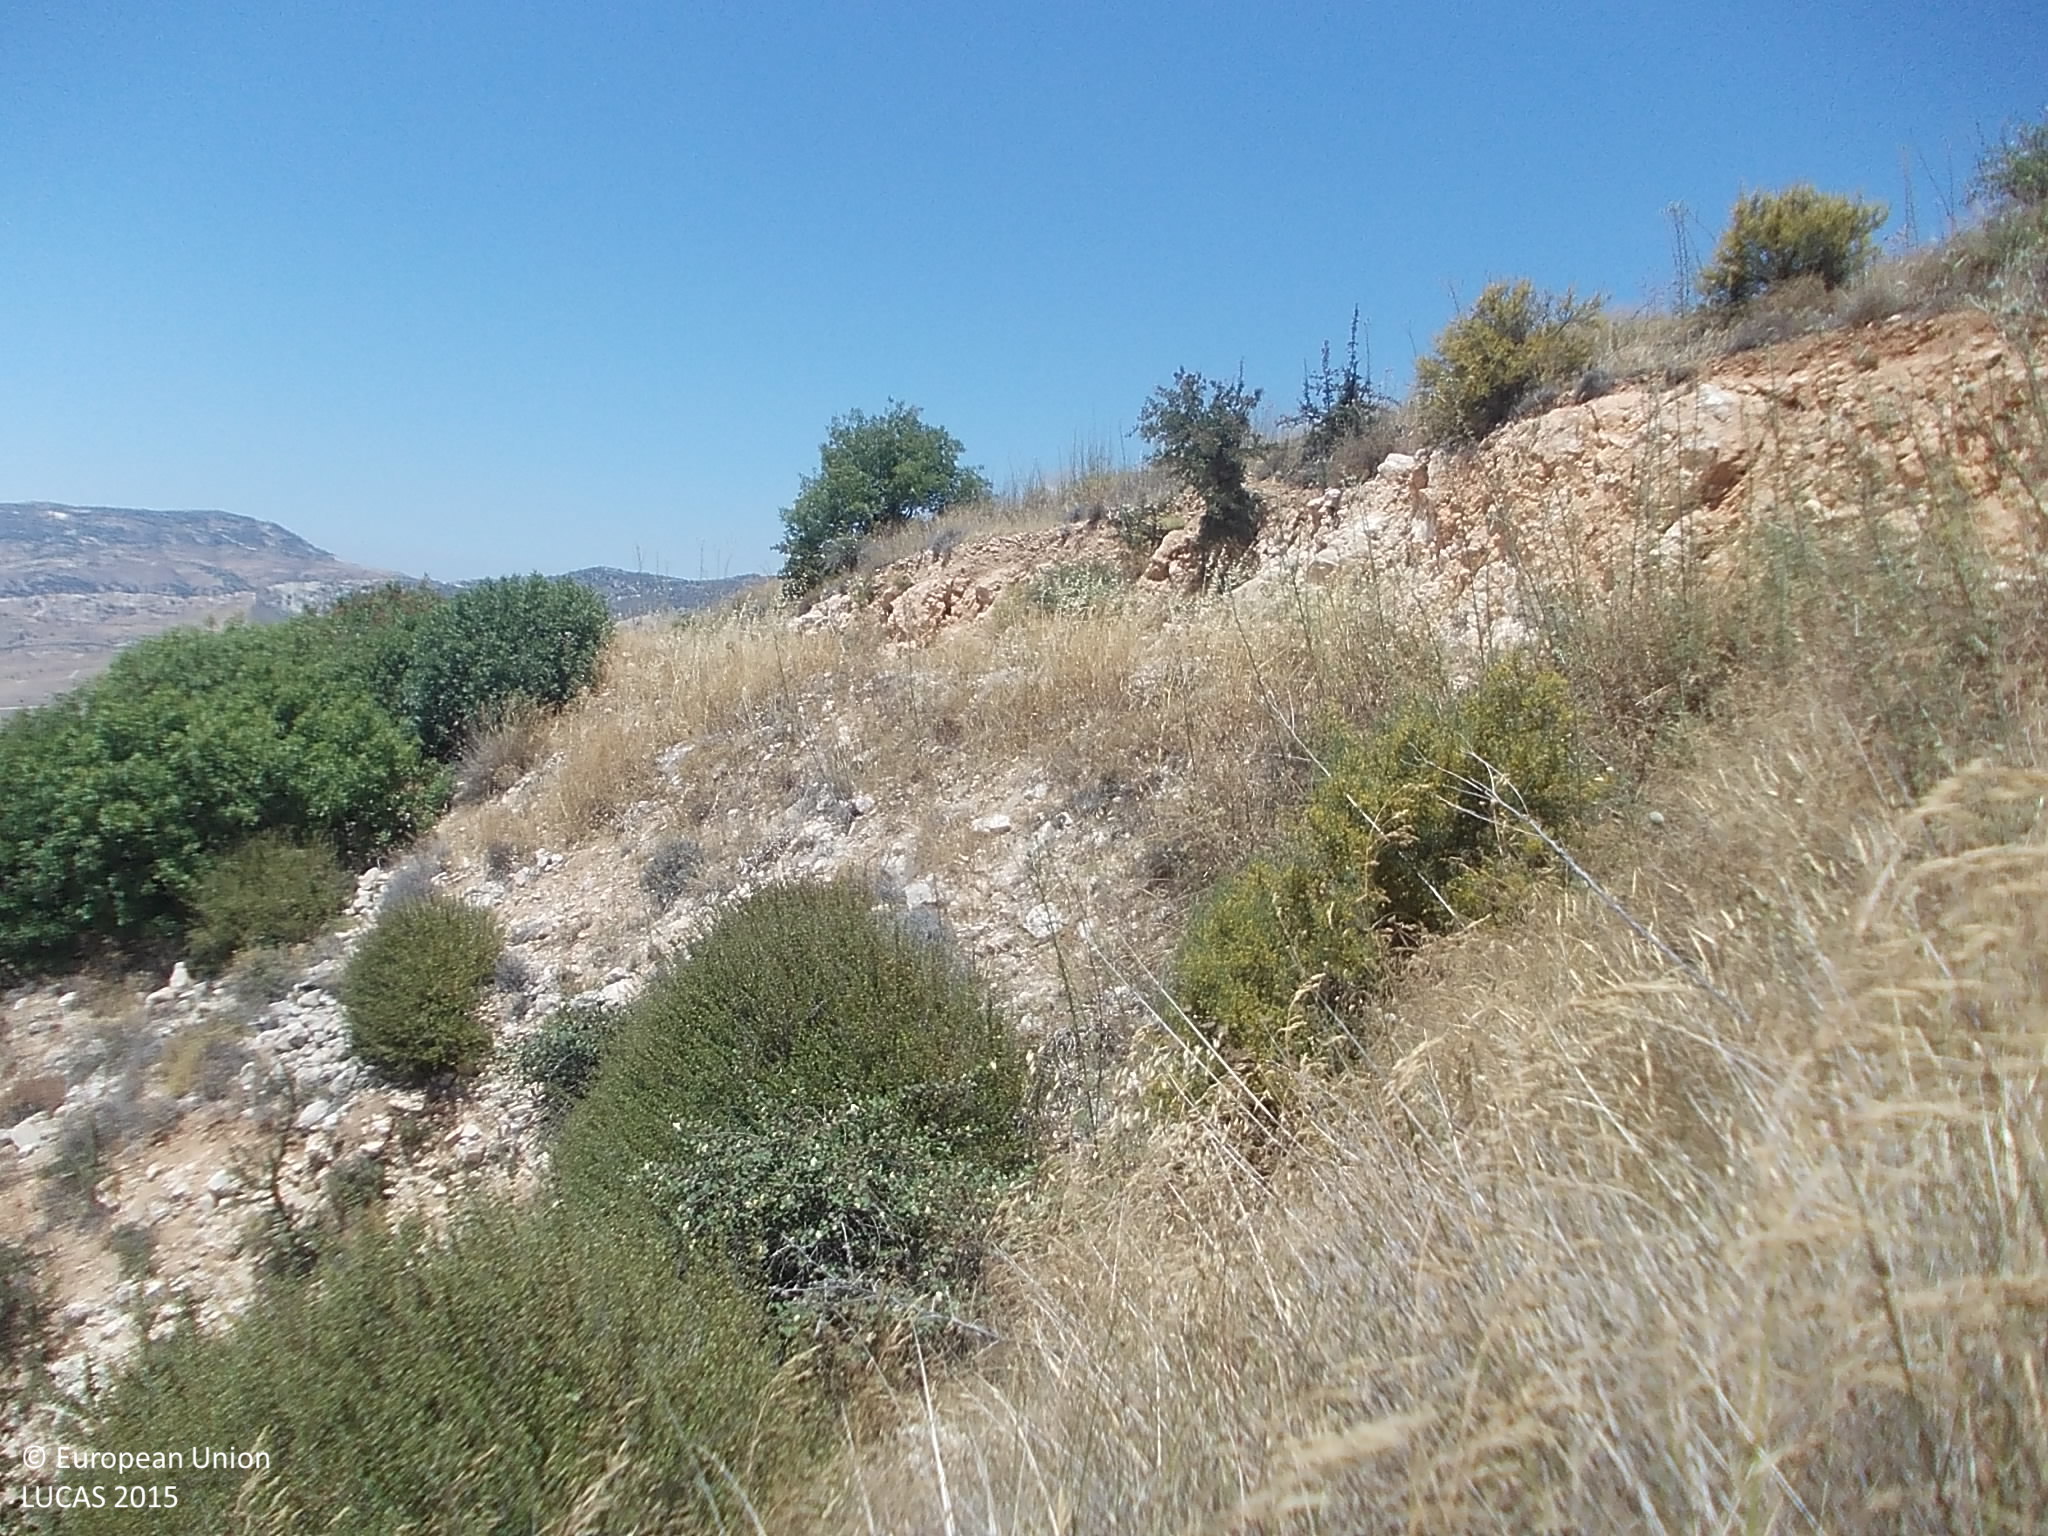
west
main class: Grassland
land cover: Grassland with sparse tree/shrub cover
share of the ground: > 75 %
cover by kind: herbaceous plants 75 %, unconsolidated bare surface 10 %, broadleaved forest trees 5 %, shrubs 5 %, consolidated bare surface 5 %
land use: Semi-natural and natural areas not in use
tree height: < 5 m
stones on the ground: 25 - 50 %
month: July
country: CY
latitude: 34.8238
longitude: 32.7353
